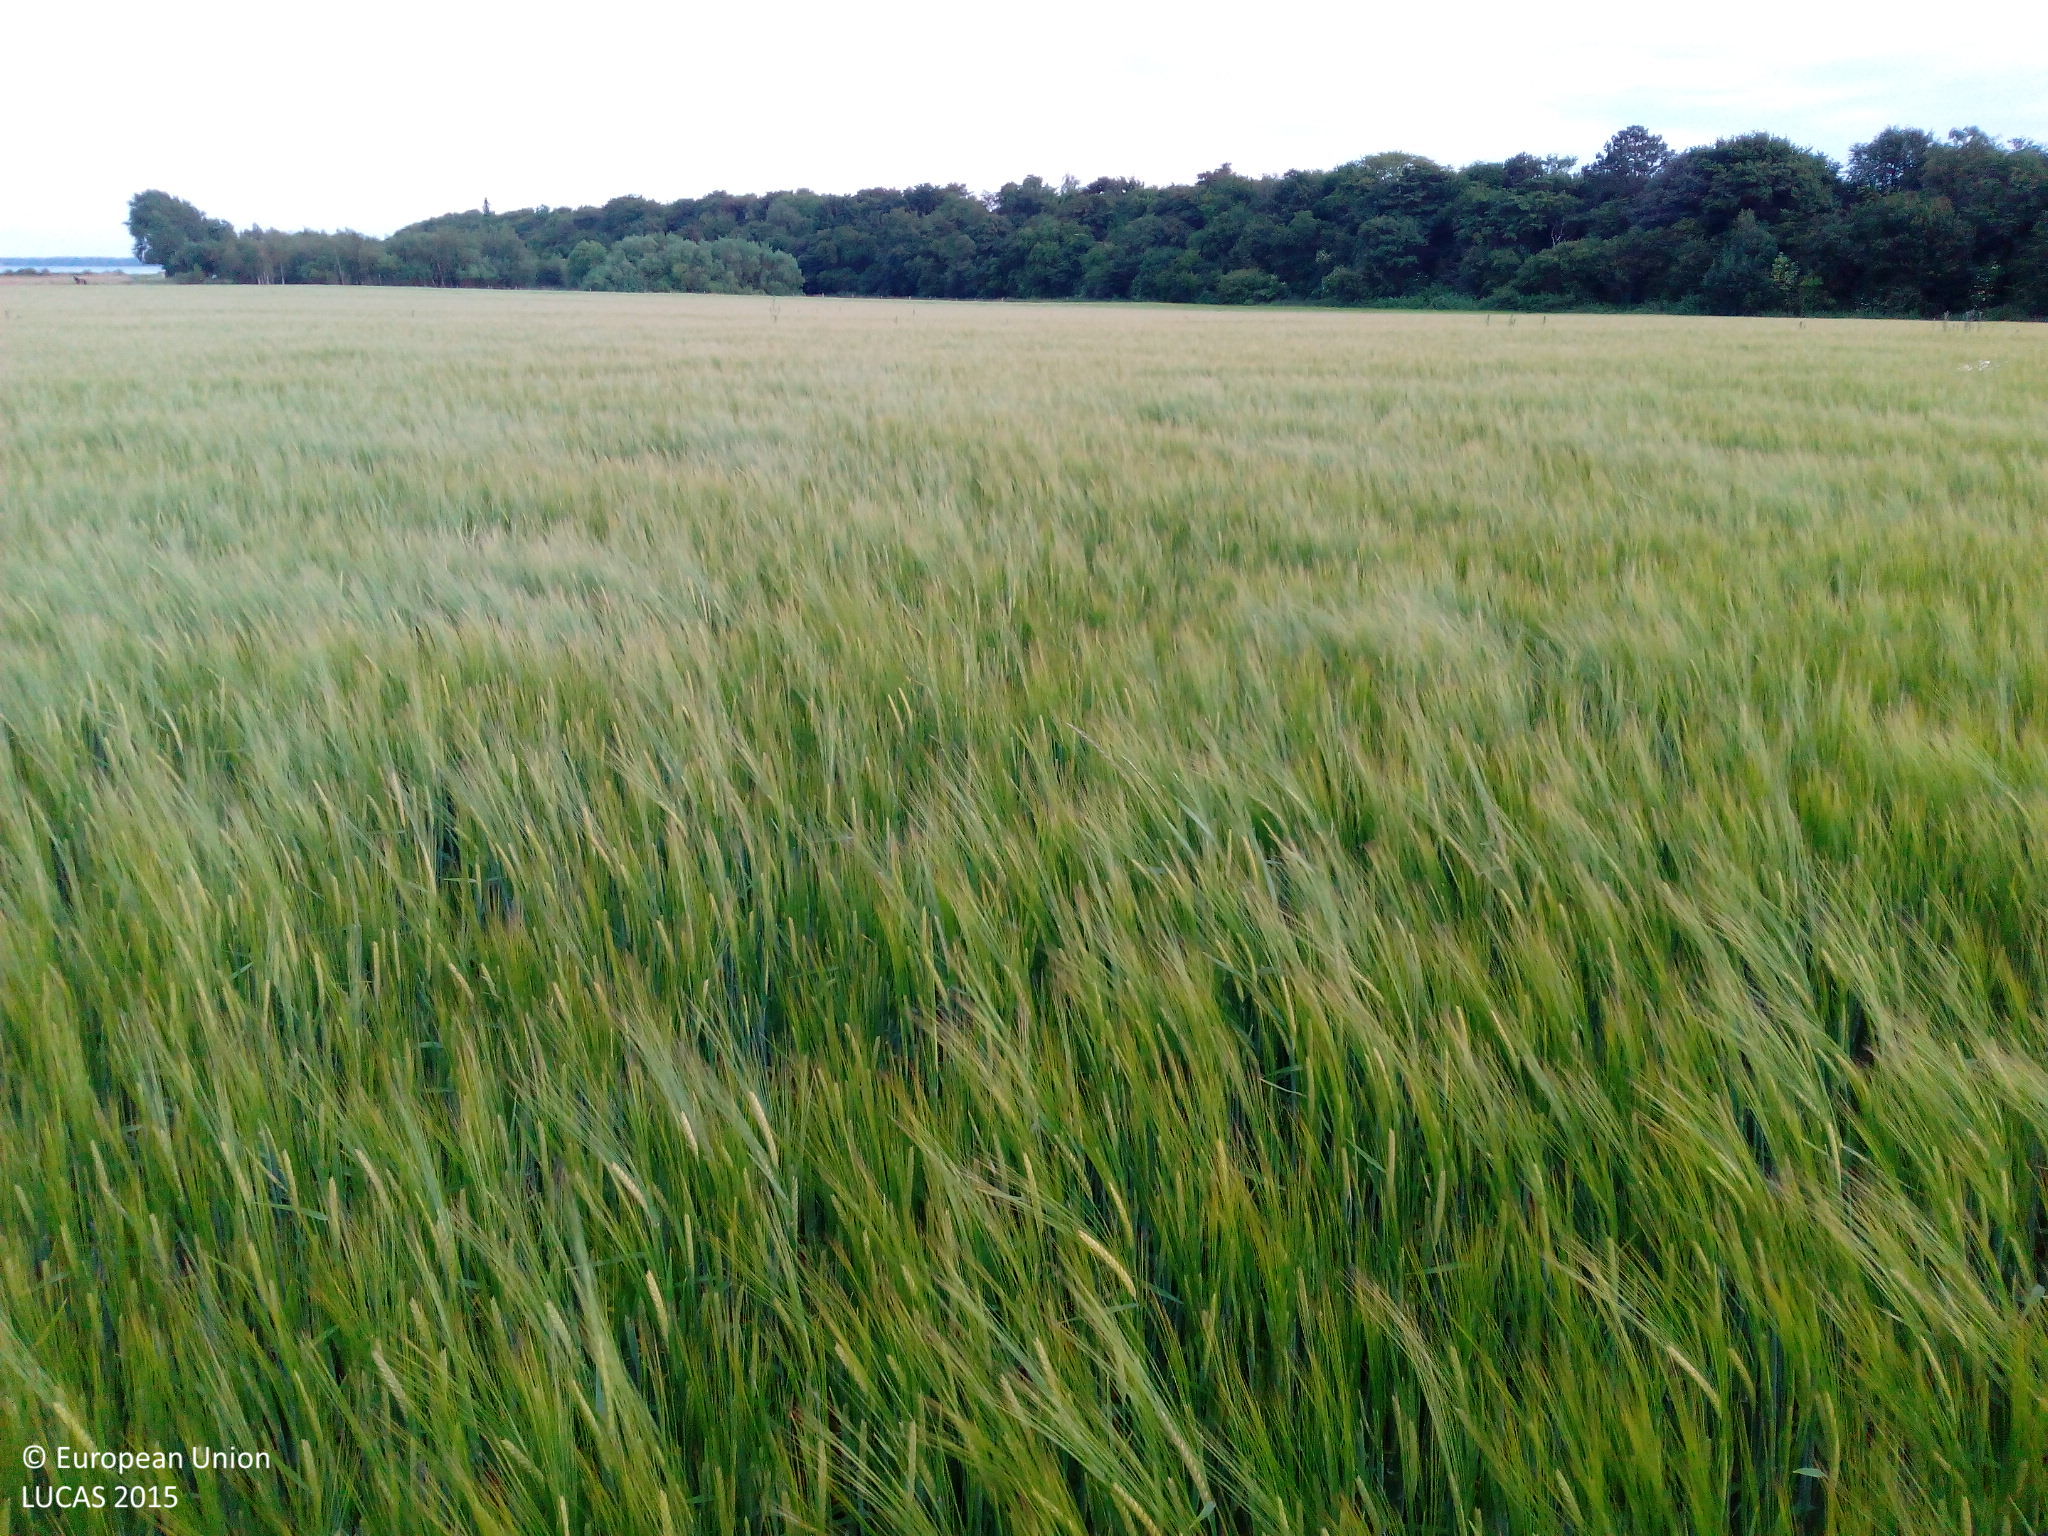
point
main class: Cropland
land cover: Barley
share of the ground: > 75 %
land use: Agriculture (excluding fallow land and kitchen gardens)
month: June
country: DK
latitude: 54.9872
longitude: 11.8897
